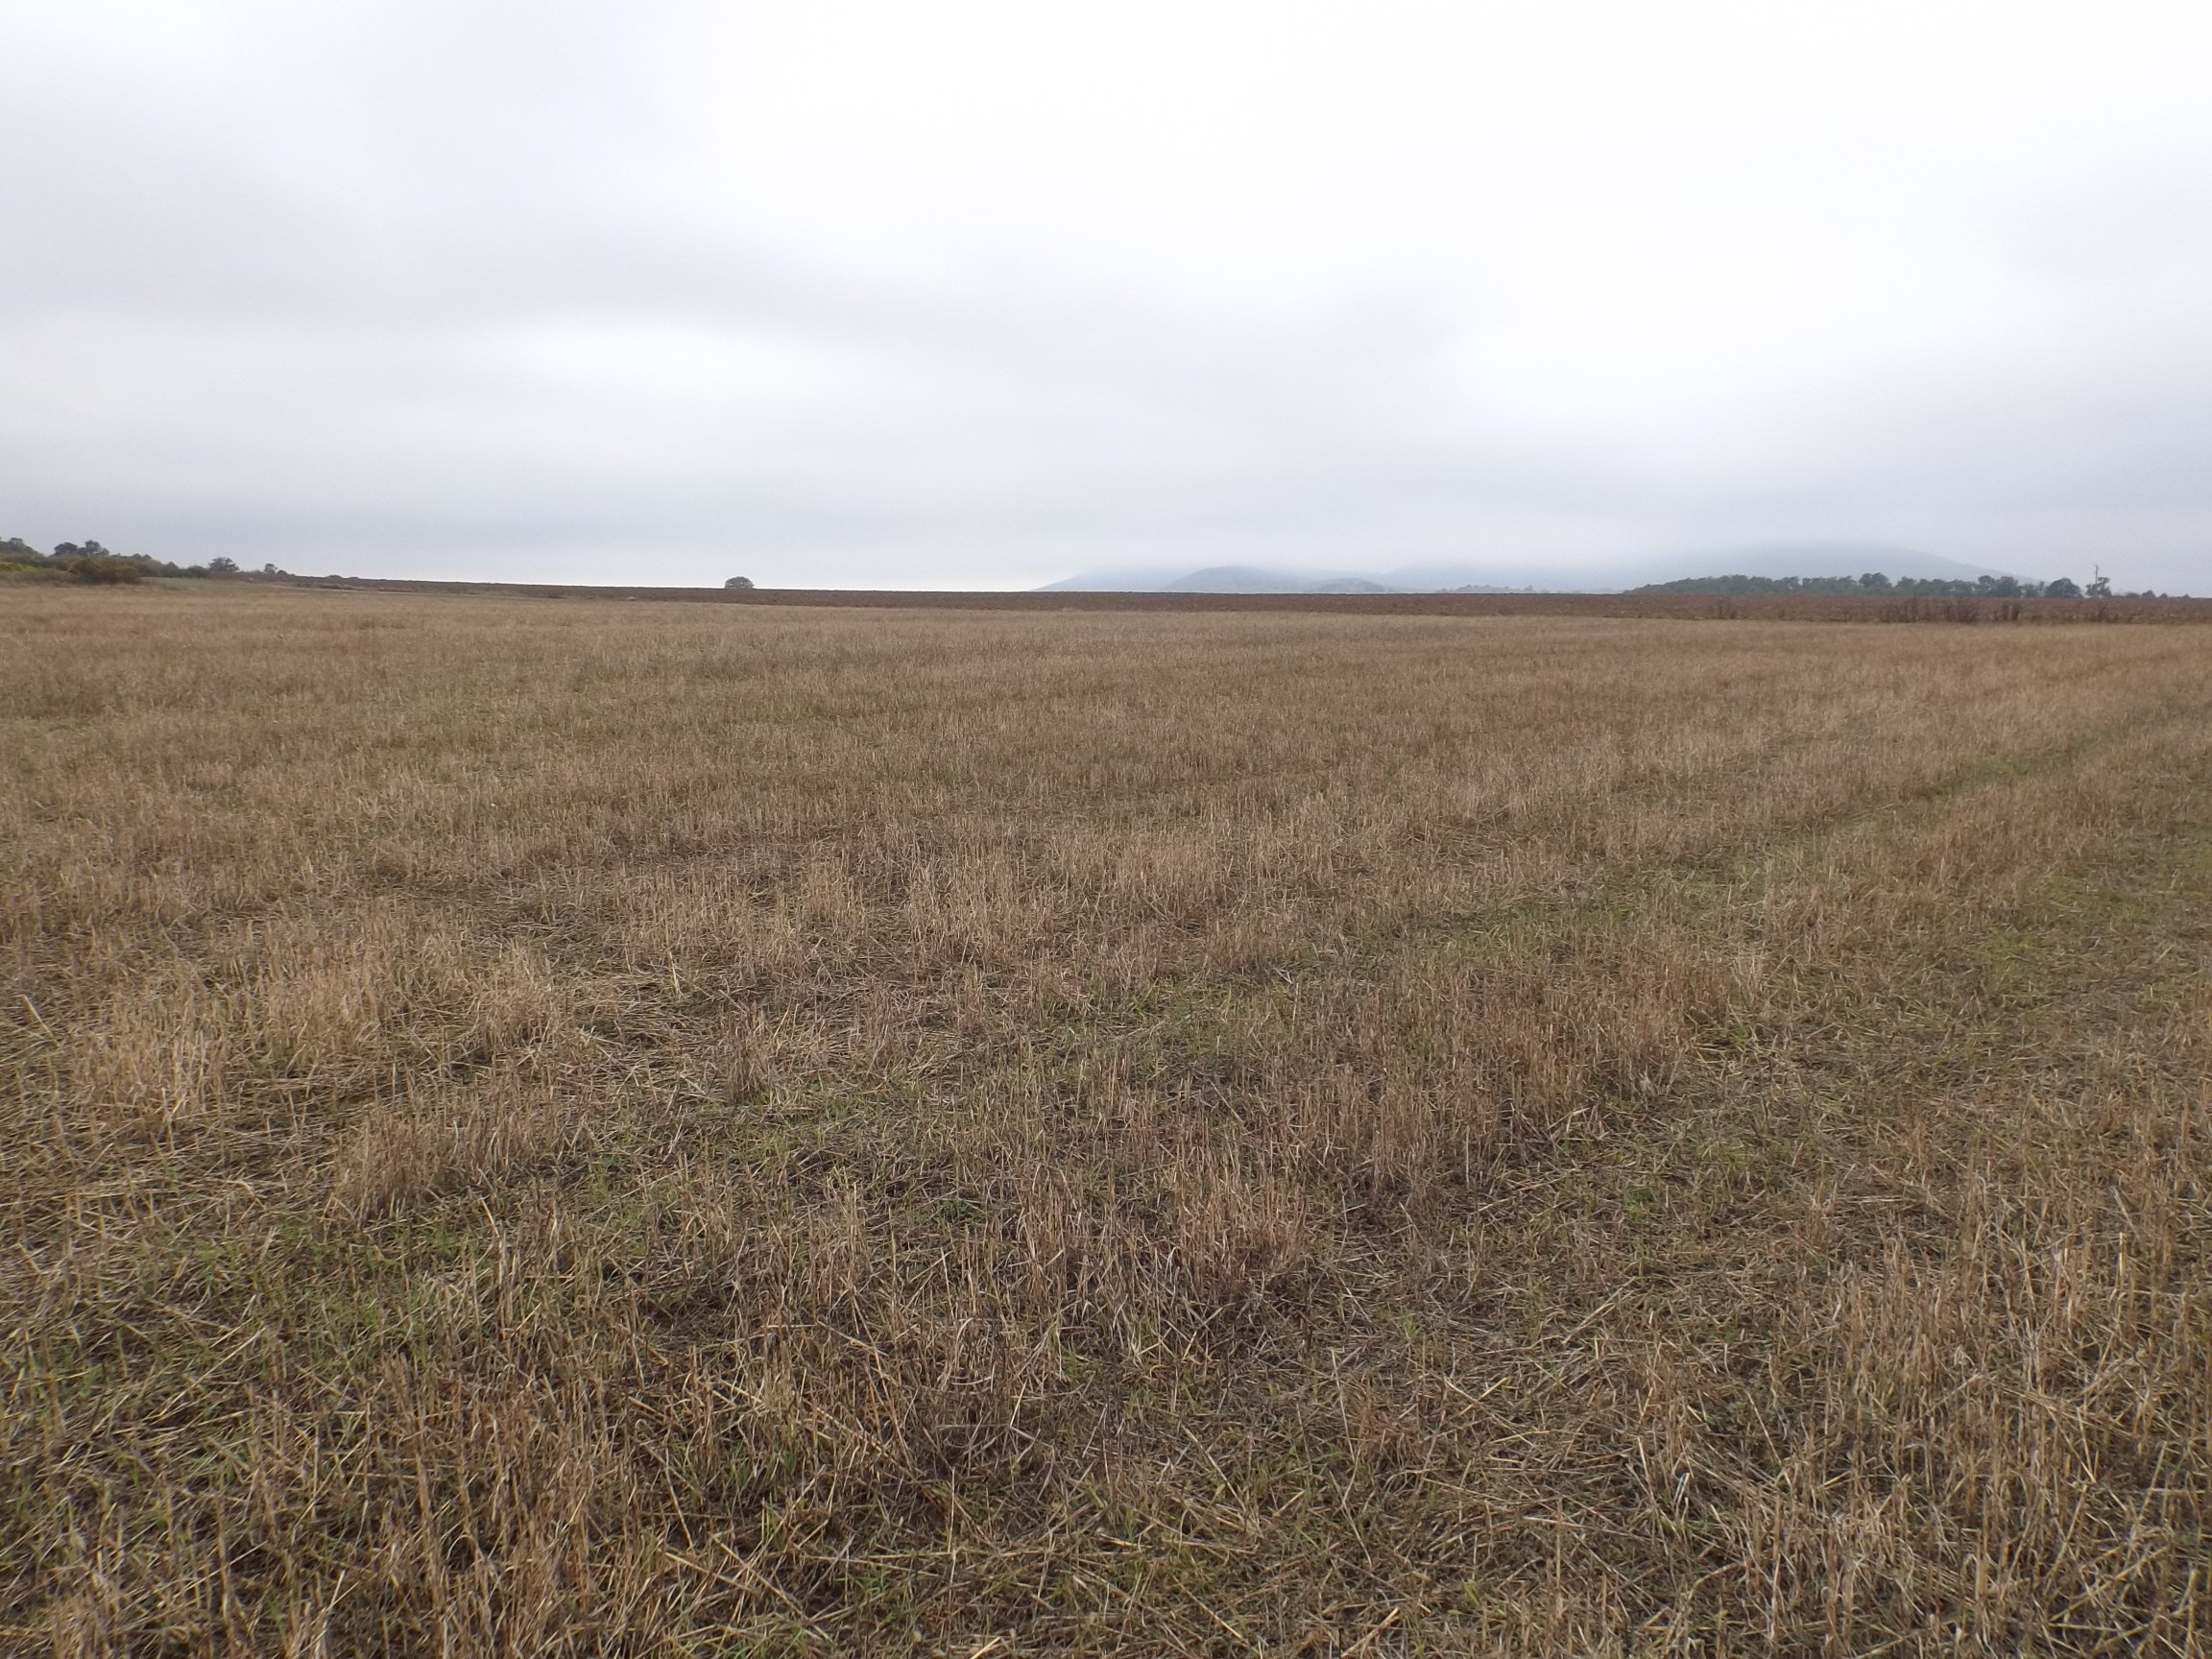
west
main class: Cropland
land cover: Common wheat
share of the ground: 25 - 50 %
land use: Agriculture (excluding fallow land and kitchen gardens)
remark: Harvested field
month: October
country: BG
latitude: 43.0063
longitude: 27.2312
